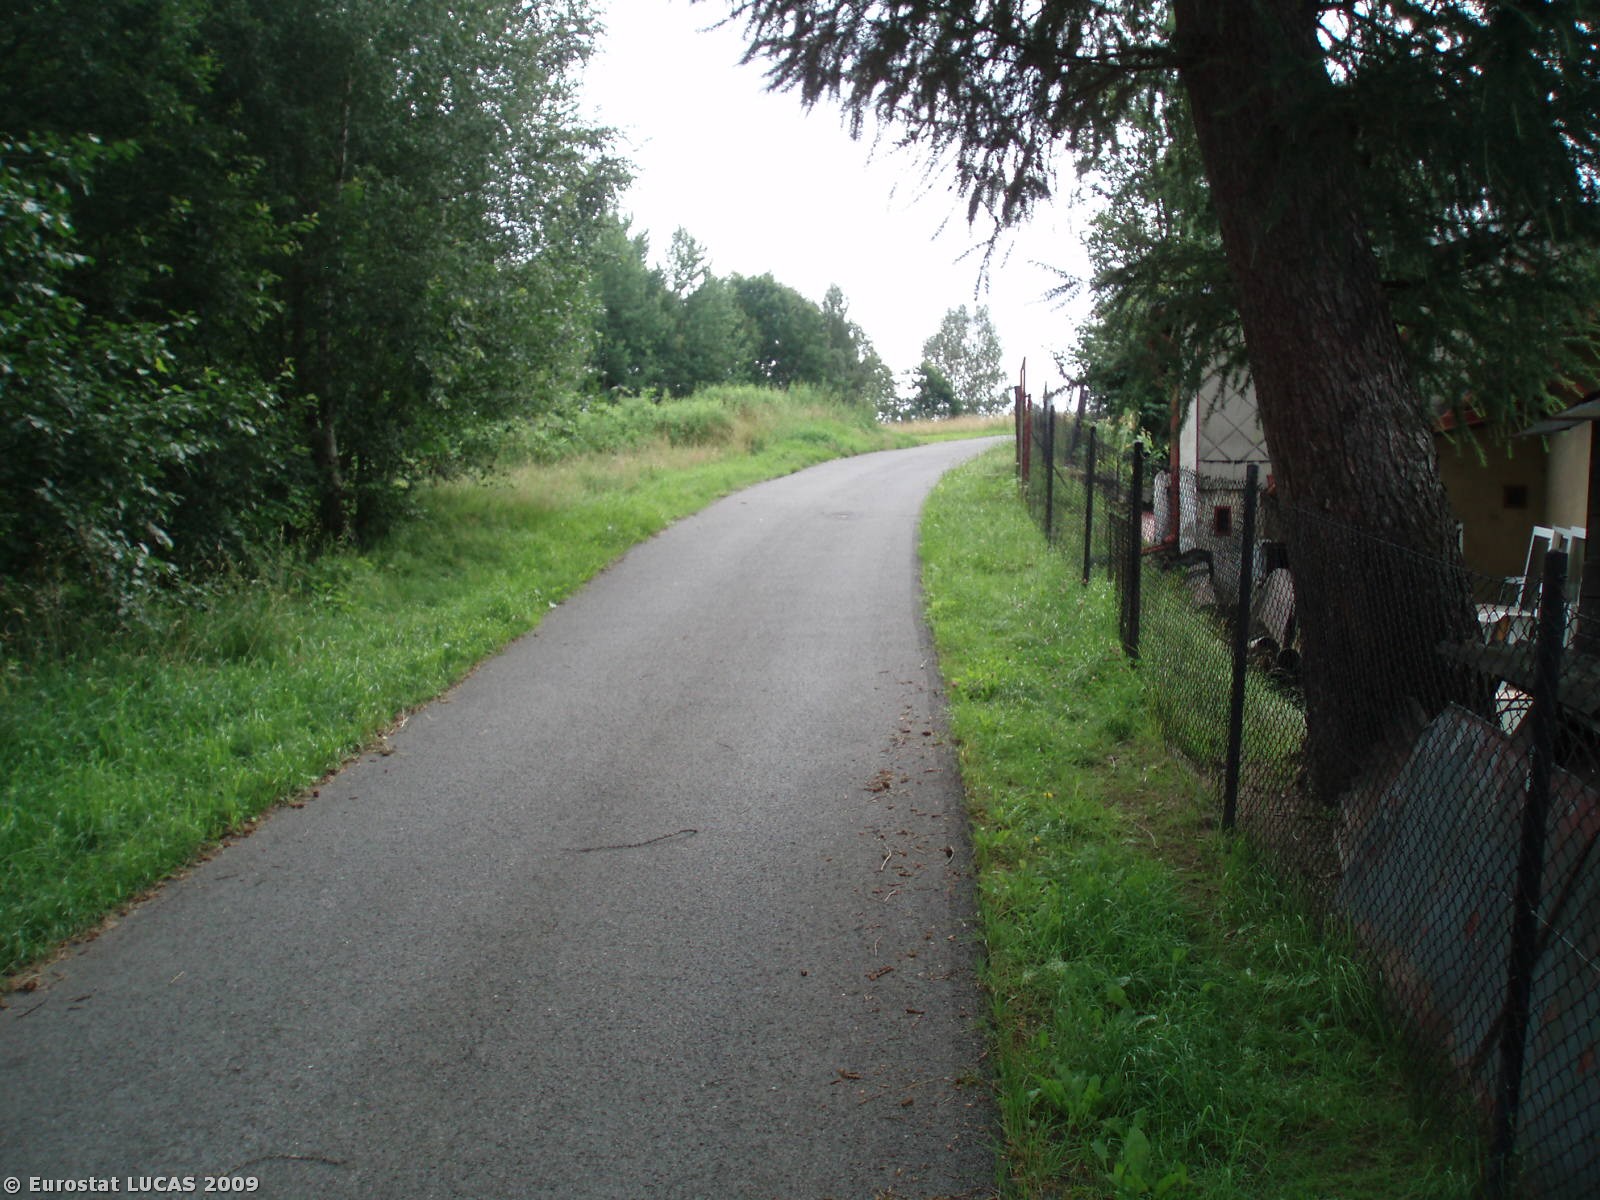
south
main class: Woodland
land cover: Mixed woodland
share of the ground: 50 - 75 %
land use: Residential
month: July
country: CZ
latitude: 50.7372
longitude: 15.0900
